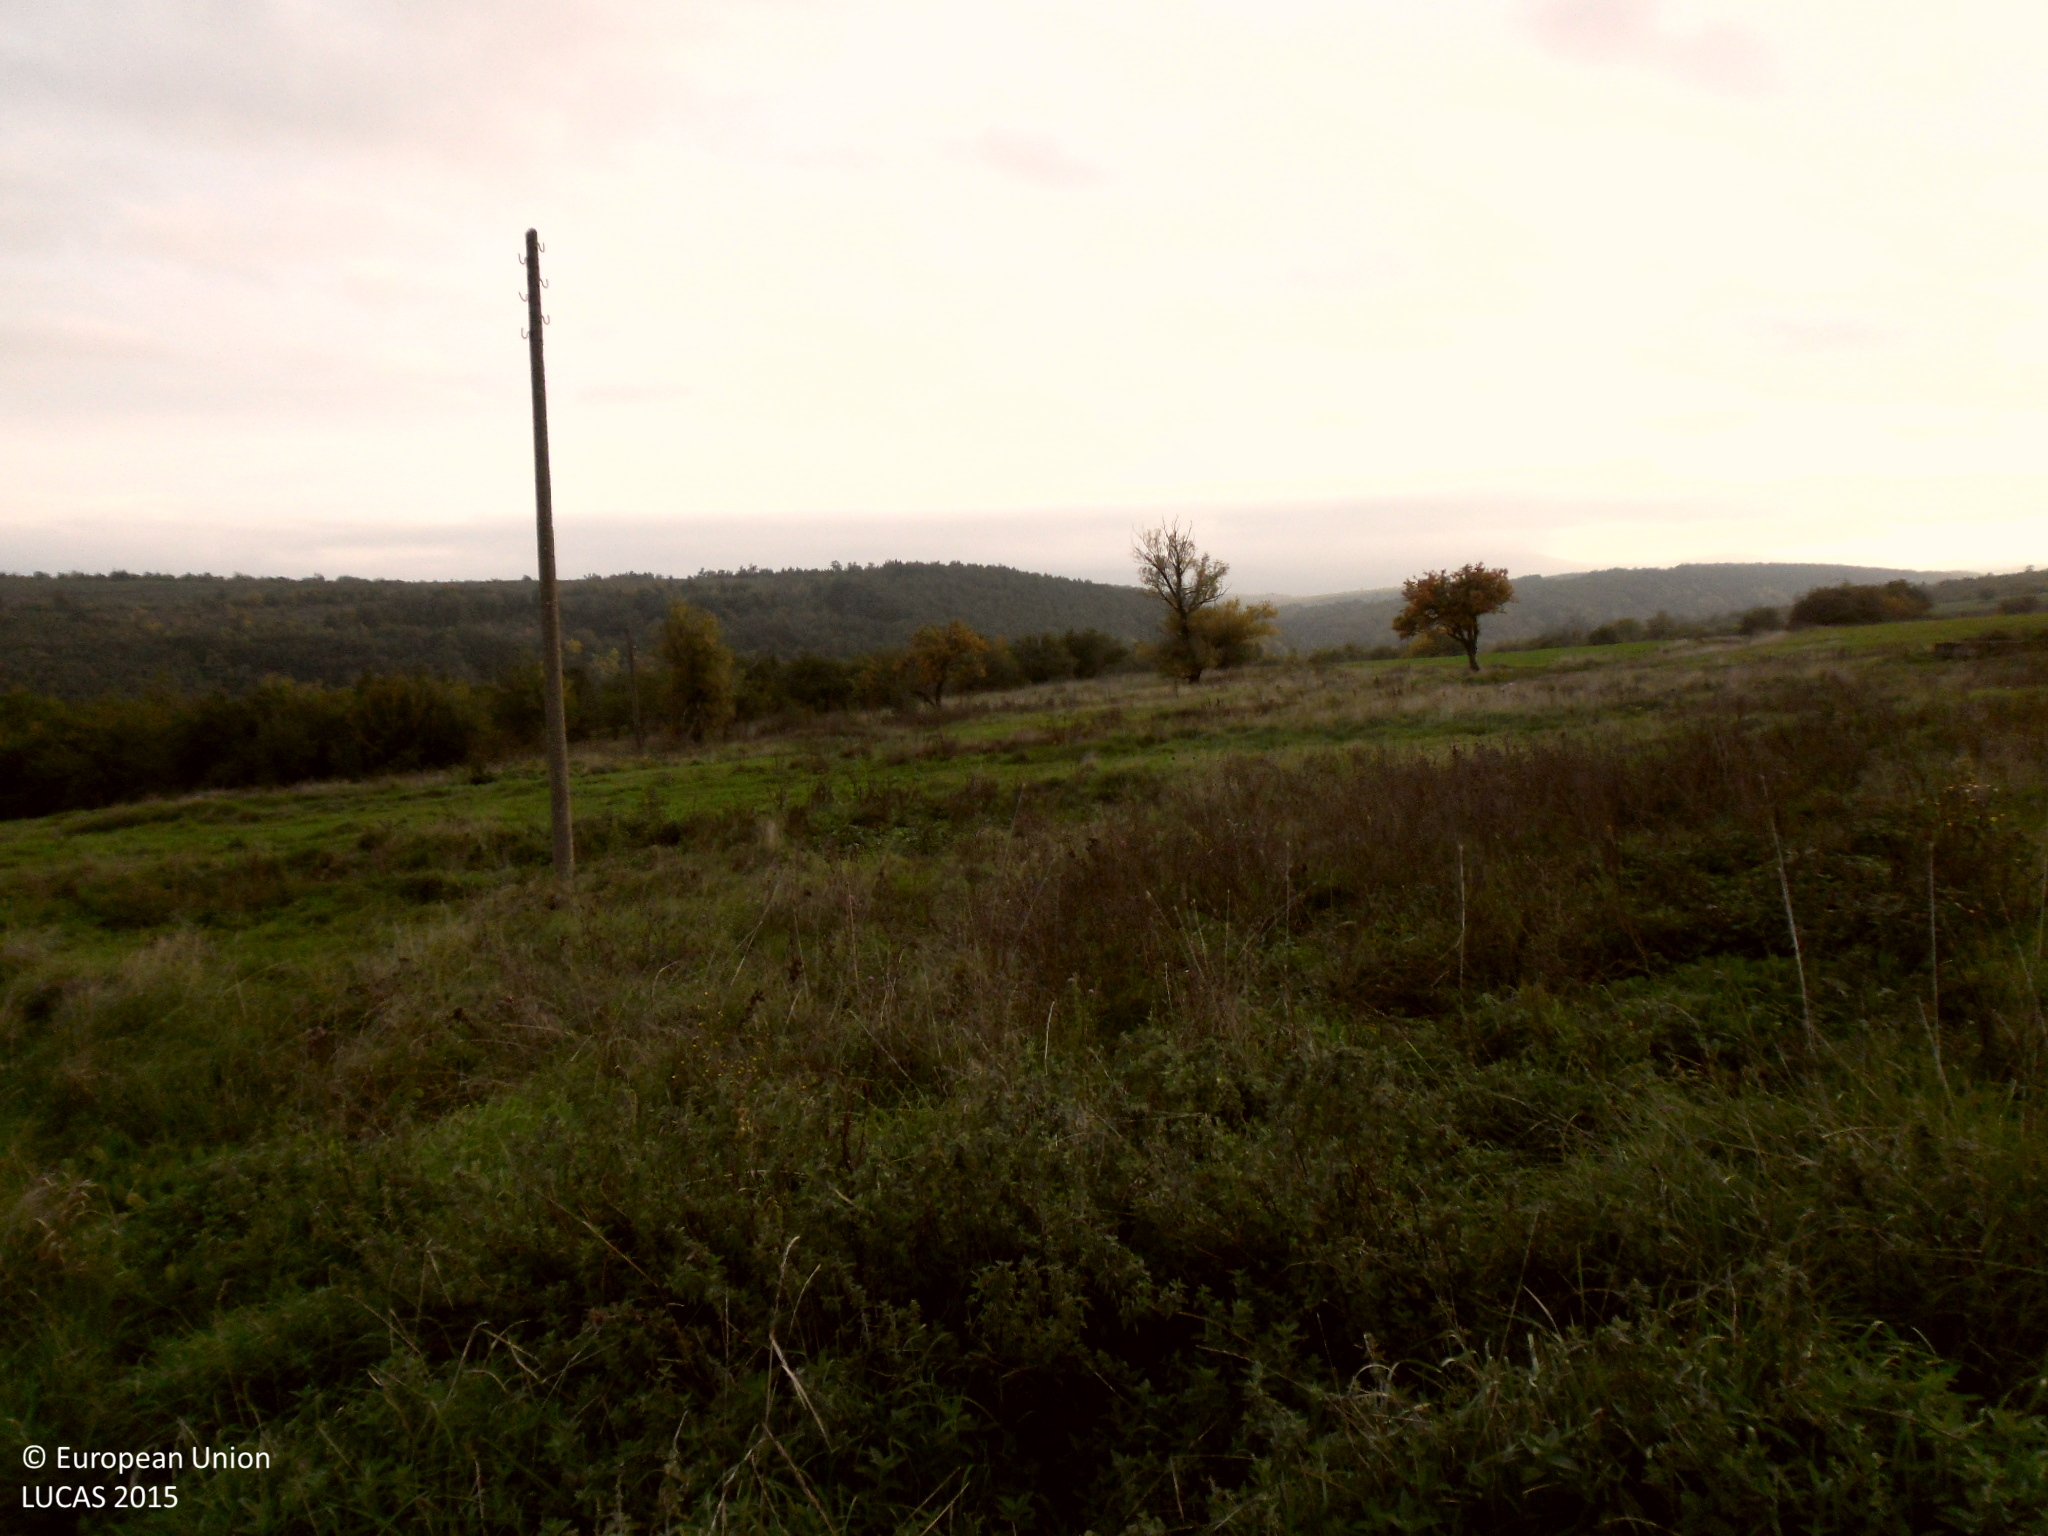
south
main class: Grassland
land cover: Grassland without tree/shrub cover
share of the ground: > 75 %
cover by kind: herbaceous plants 100 %
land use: Agriculture (excluding fallow land and kitchen gardens)
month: October
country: BG
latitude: 43.8308
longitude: 22.4809
